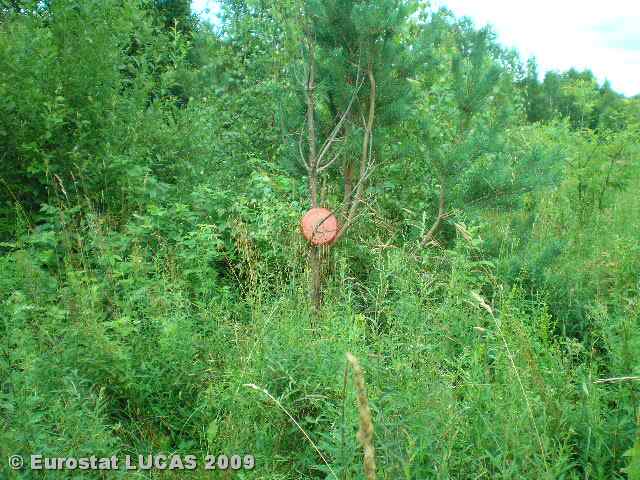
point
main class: Woodland
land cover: Broadleaved woodland
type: hemiboreal forest and nemoral coniferous forest and mixed broadleaved-coniferous forest
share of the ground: > 75 %
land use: Forestry
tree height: > 5 m
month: July
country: LT
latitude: 54.9839
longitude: 25.3264
